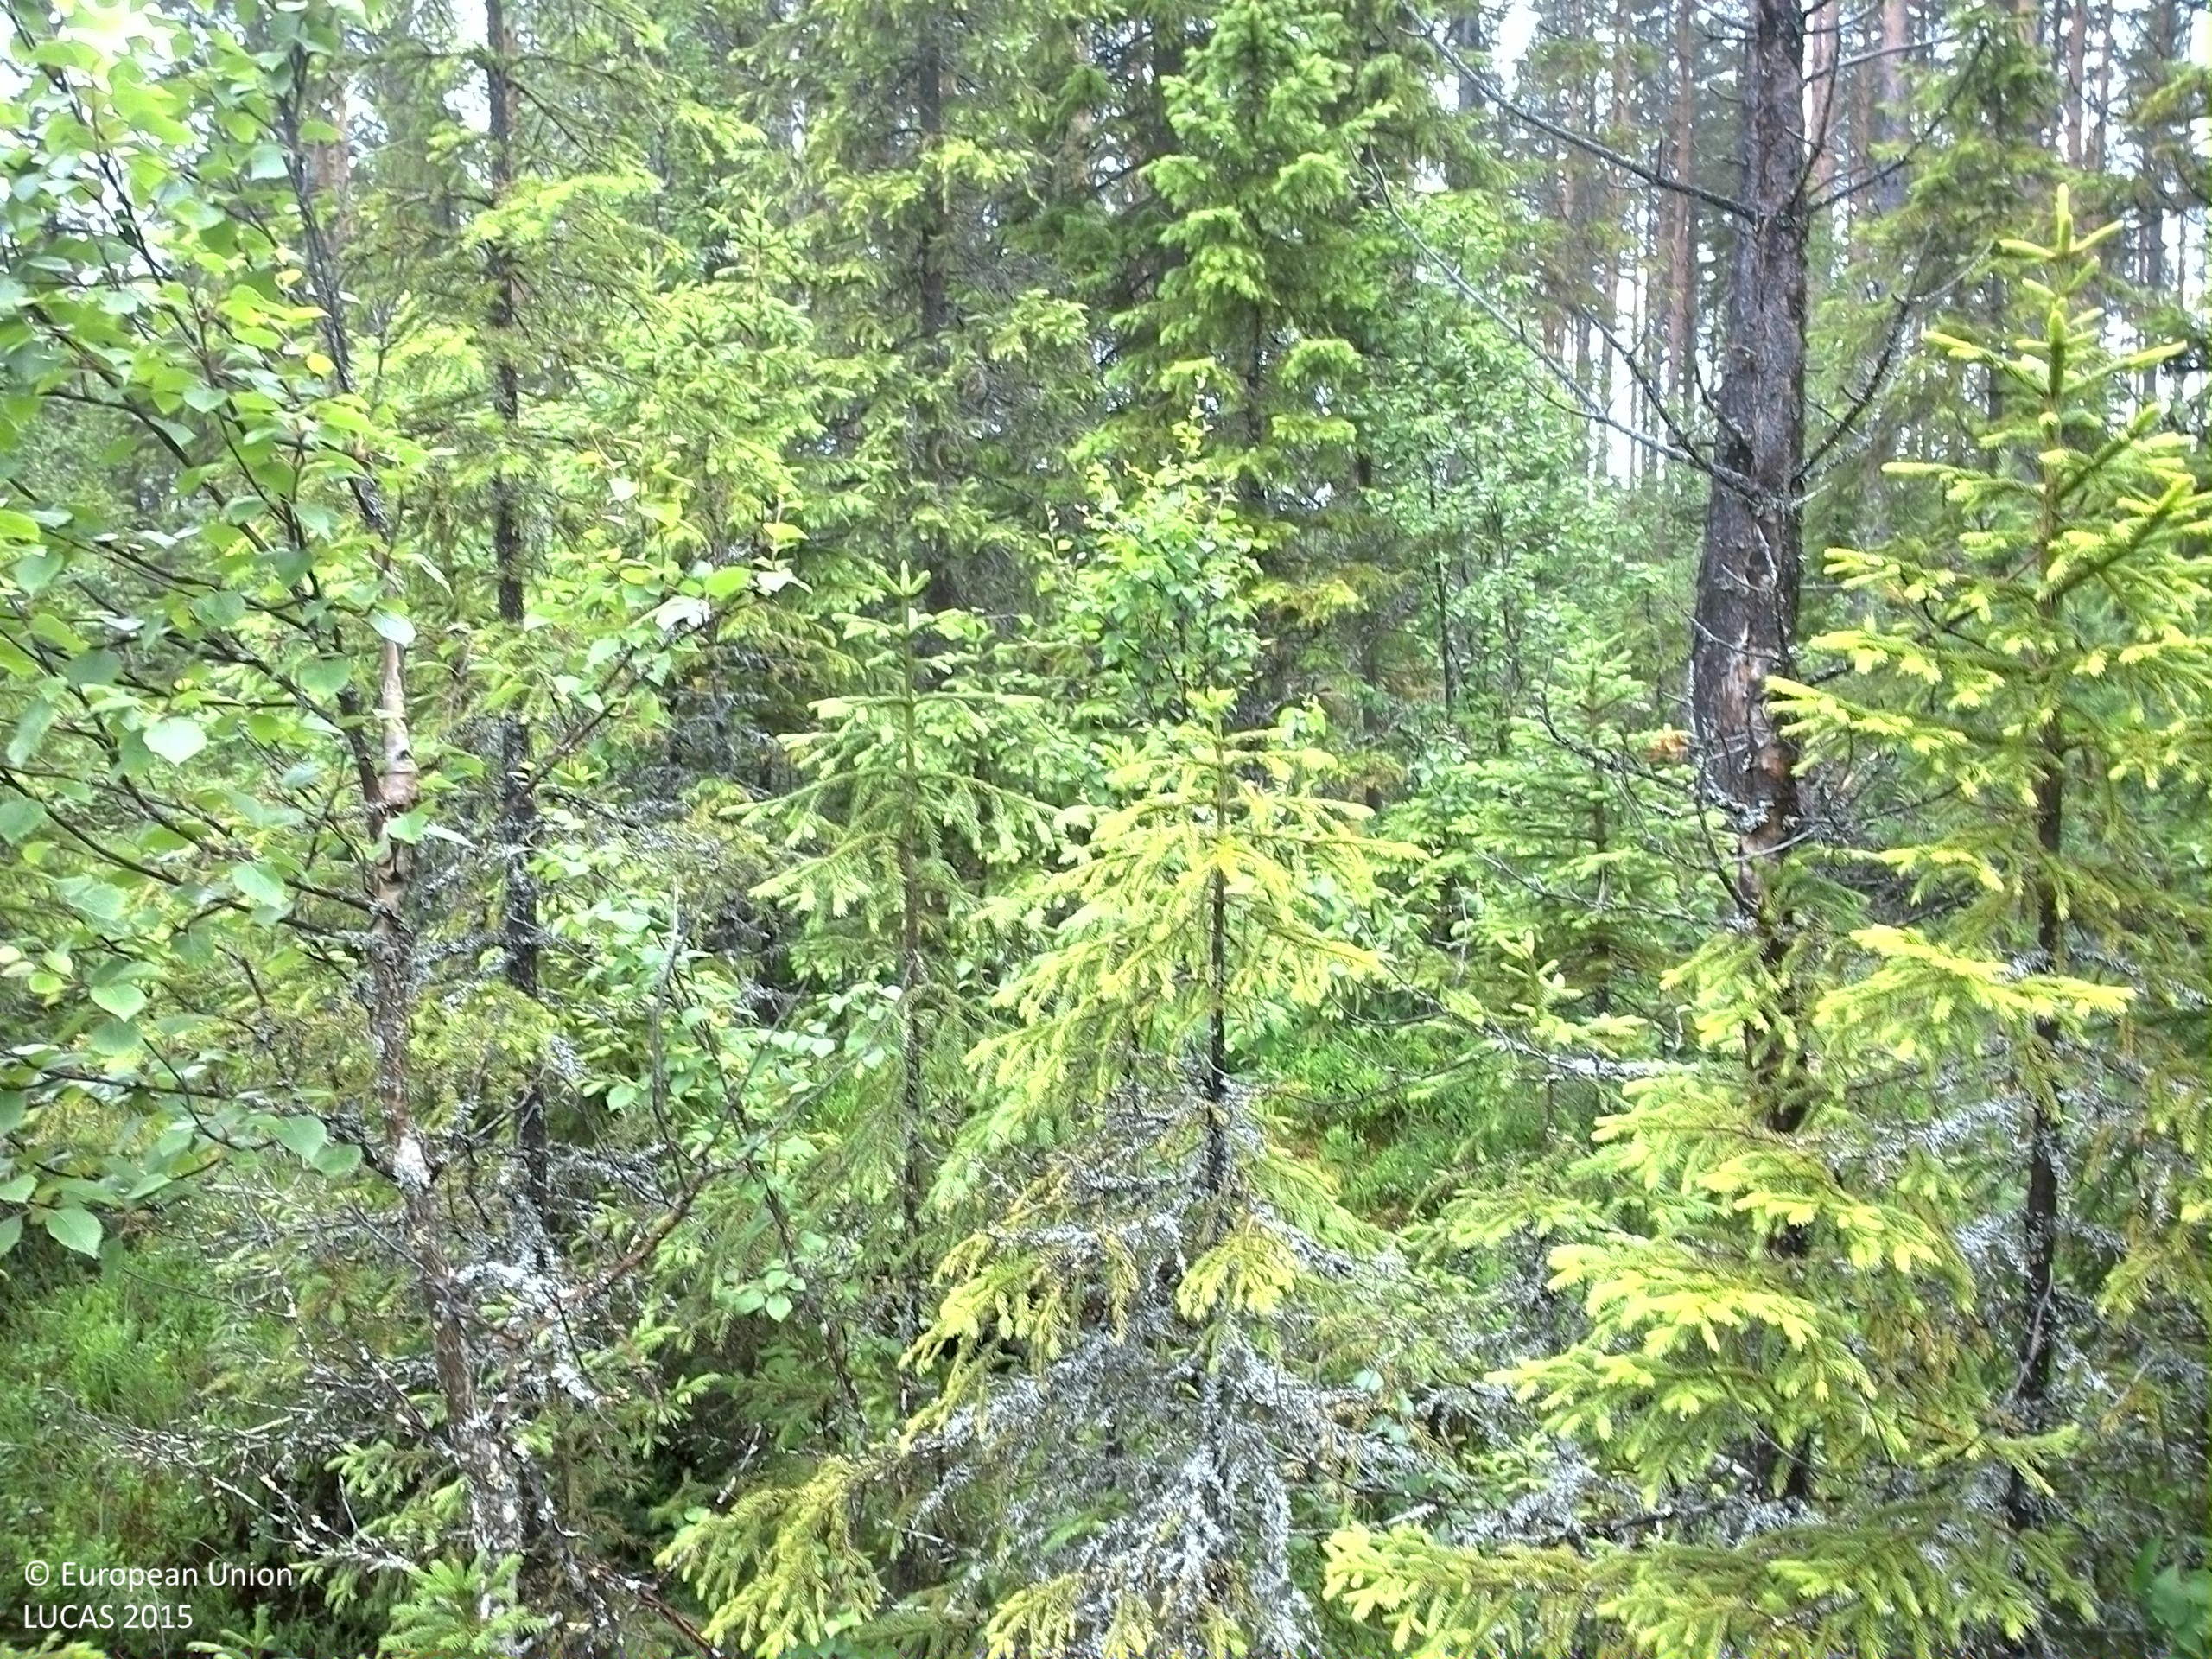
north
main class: Woodland
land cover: Spruce dominated mixed woodland
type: boreal forest
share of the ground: > 75 %
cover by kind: coniferous forest trees 55 %, broadleaved forest trees 30 %, shrubs 15 %
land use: Forestry
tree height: < 5 m
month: July
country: SE
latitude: 63.6601
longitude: 18.5199
